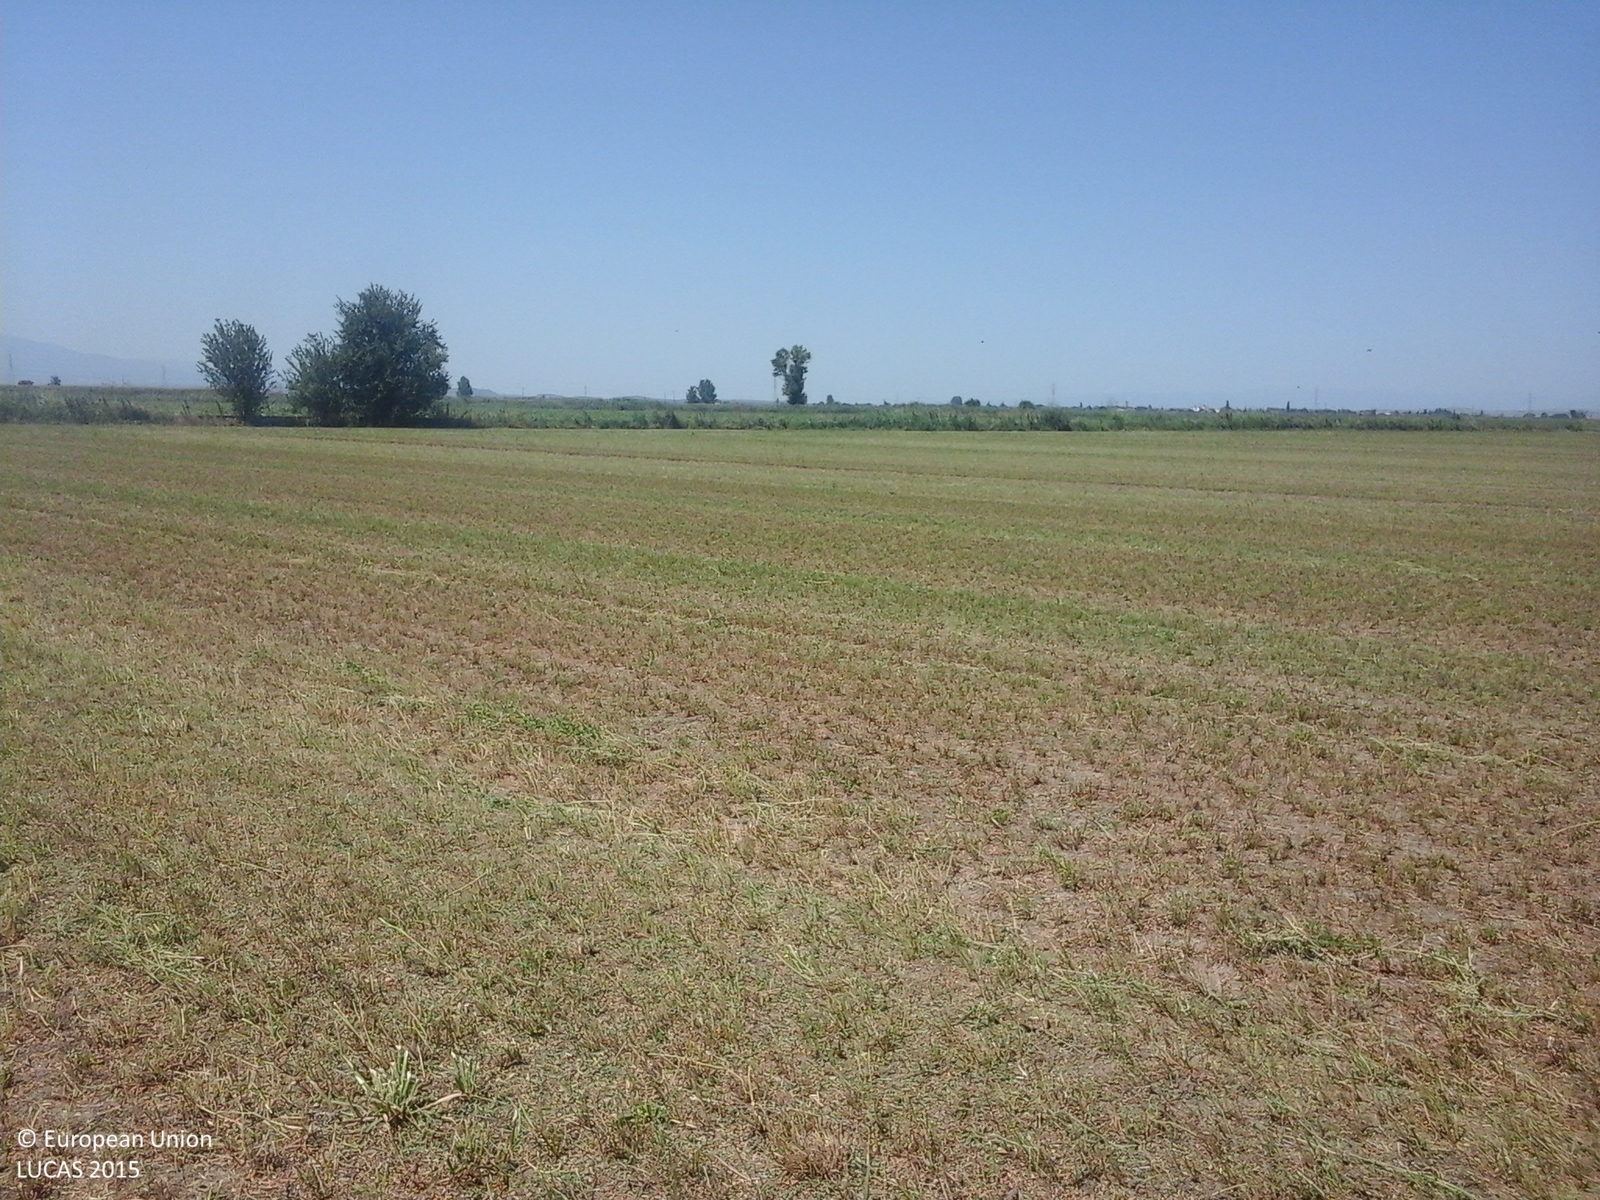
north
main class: Cropland
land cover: Clovers
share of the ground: 25 - 50 %
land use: Agriculture (excluding fallow land and kitchen gardens)
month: July
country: GR
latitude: 40.6404
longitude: 22.5964
